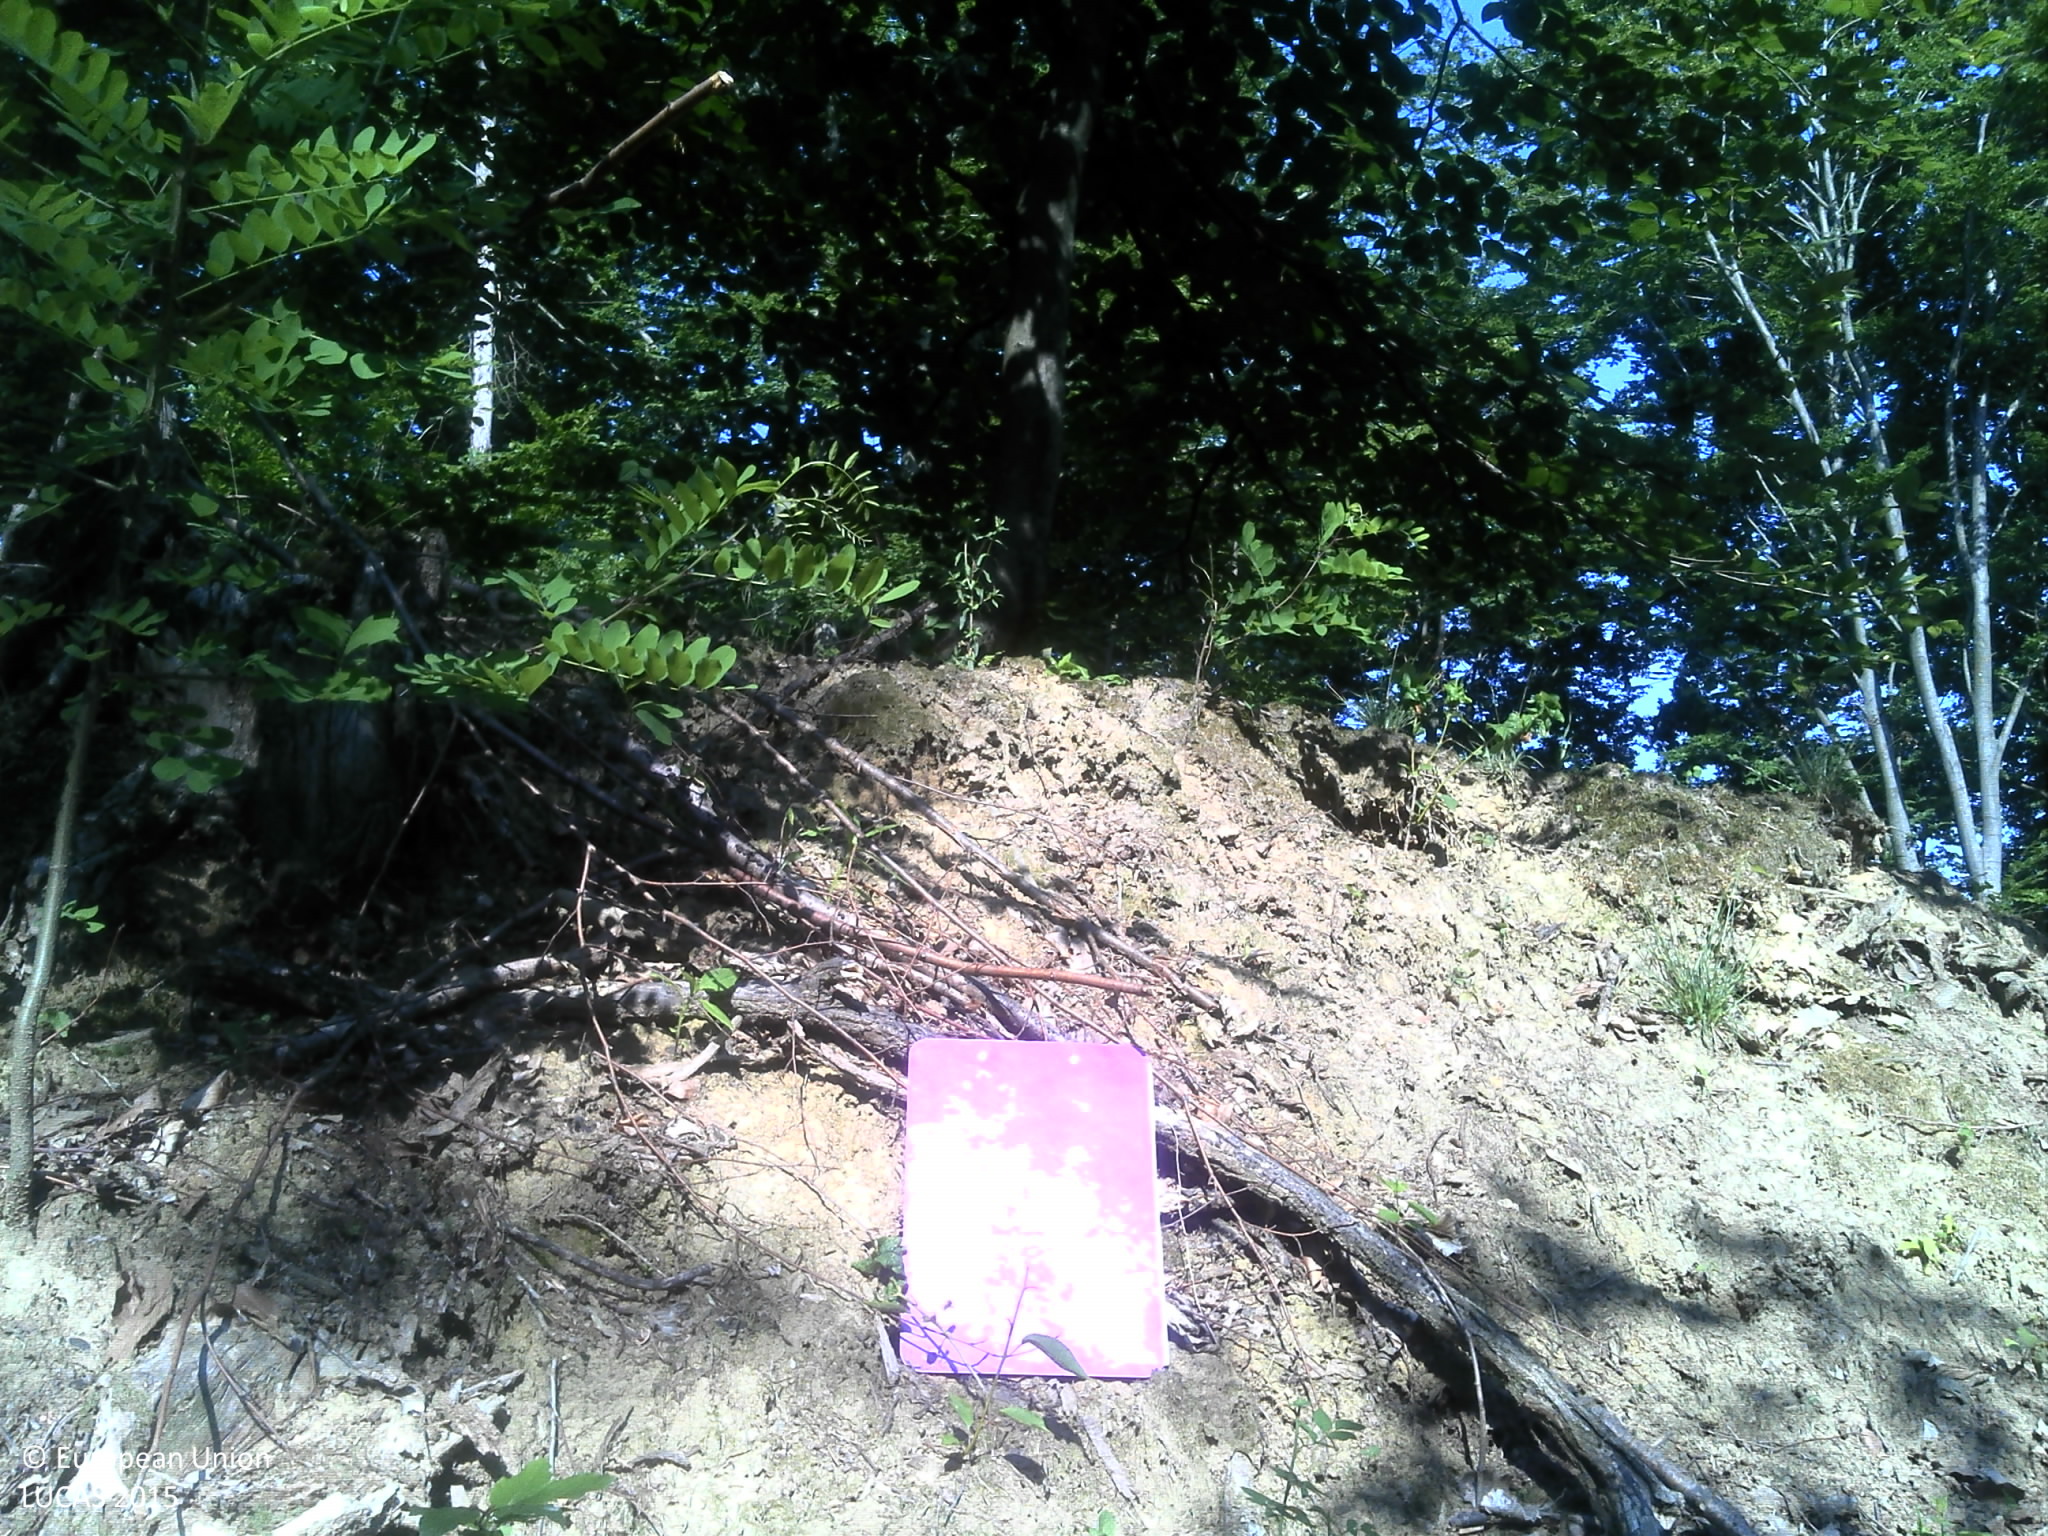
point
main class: Woodland
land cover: Broadleaved woodland
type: beech forest
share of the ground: > 75 %
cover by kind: broadleaved forest trees 90 %, herbaceous plants 5 %, lichens and mosses 5 %
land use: Forestry
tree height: > 5 m
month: June
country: HR
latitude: 45.6259
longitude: 17.6342
